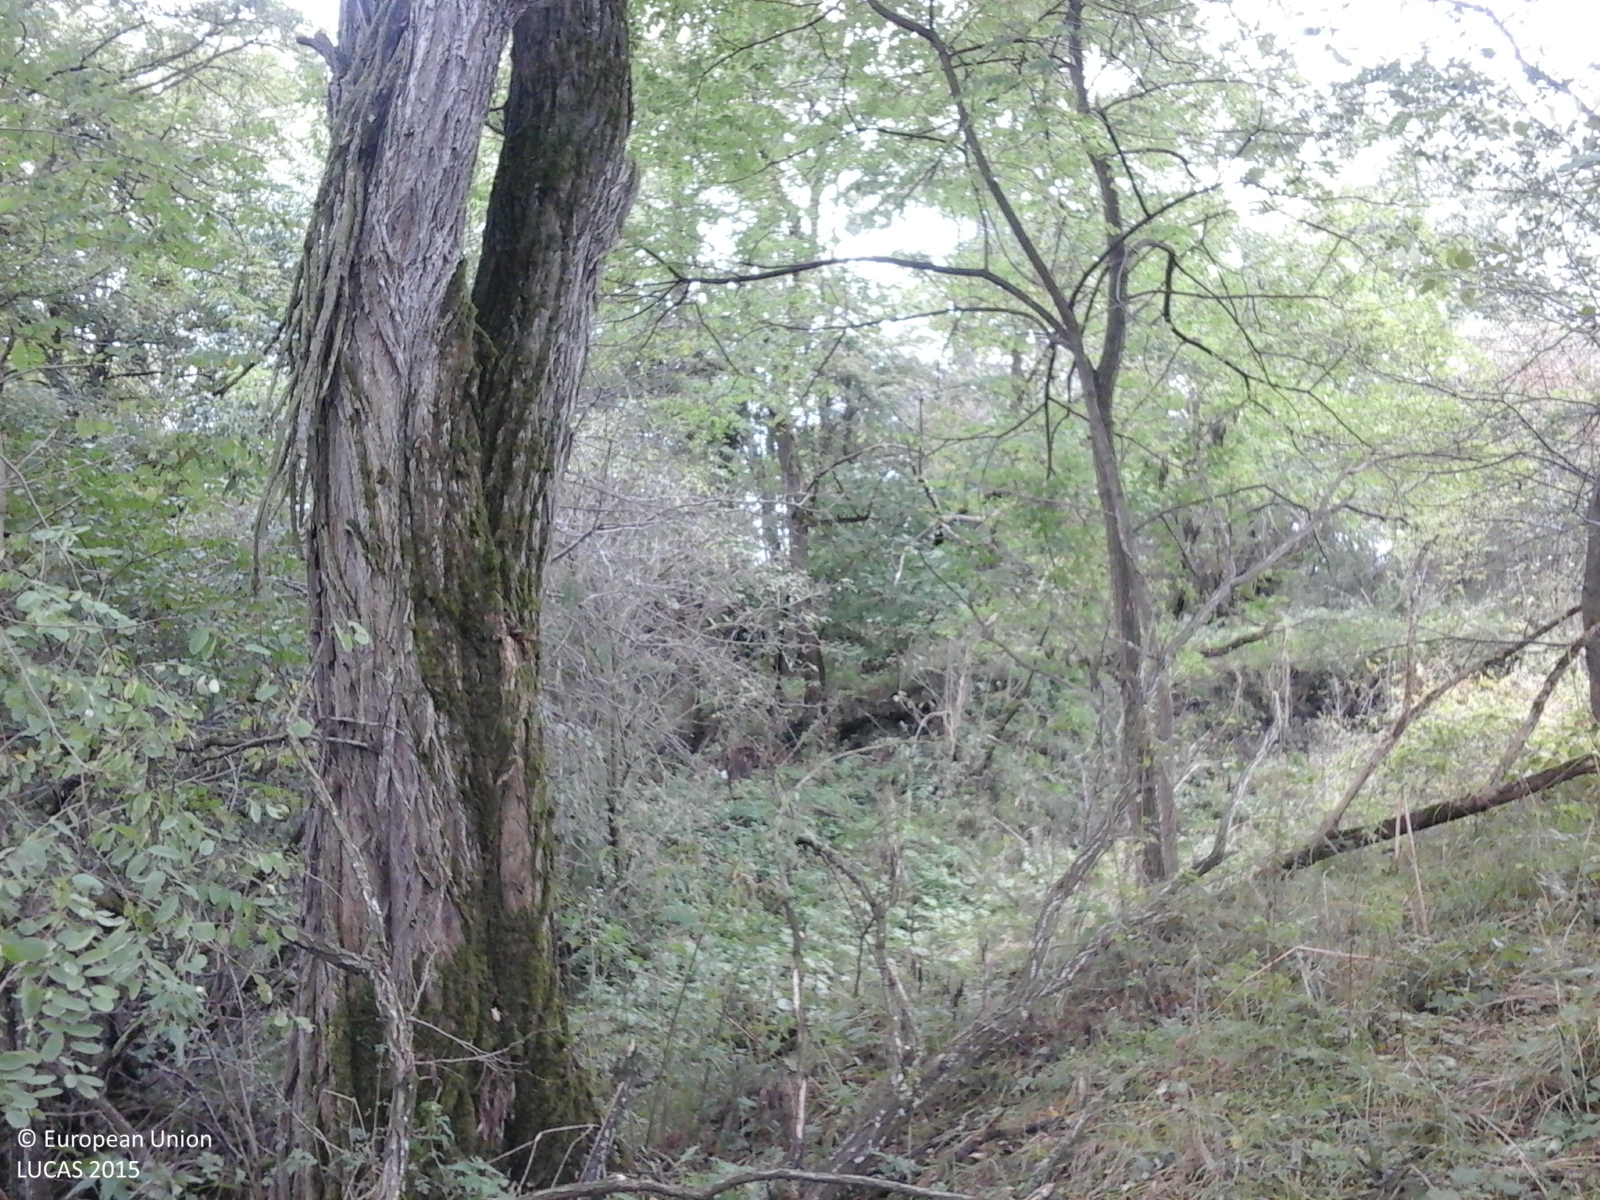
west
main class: Woodland
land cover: Broadleaved woodland
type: exotic forest
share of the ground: > 75 %
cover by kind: broadleaved forest trees 100 %
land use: Forestry
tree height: > 5 m
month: October
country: RO
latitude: 45.9045
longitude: 24.6385
